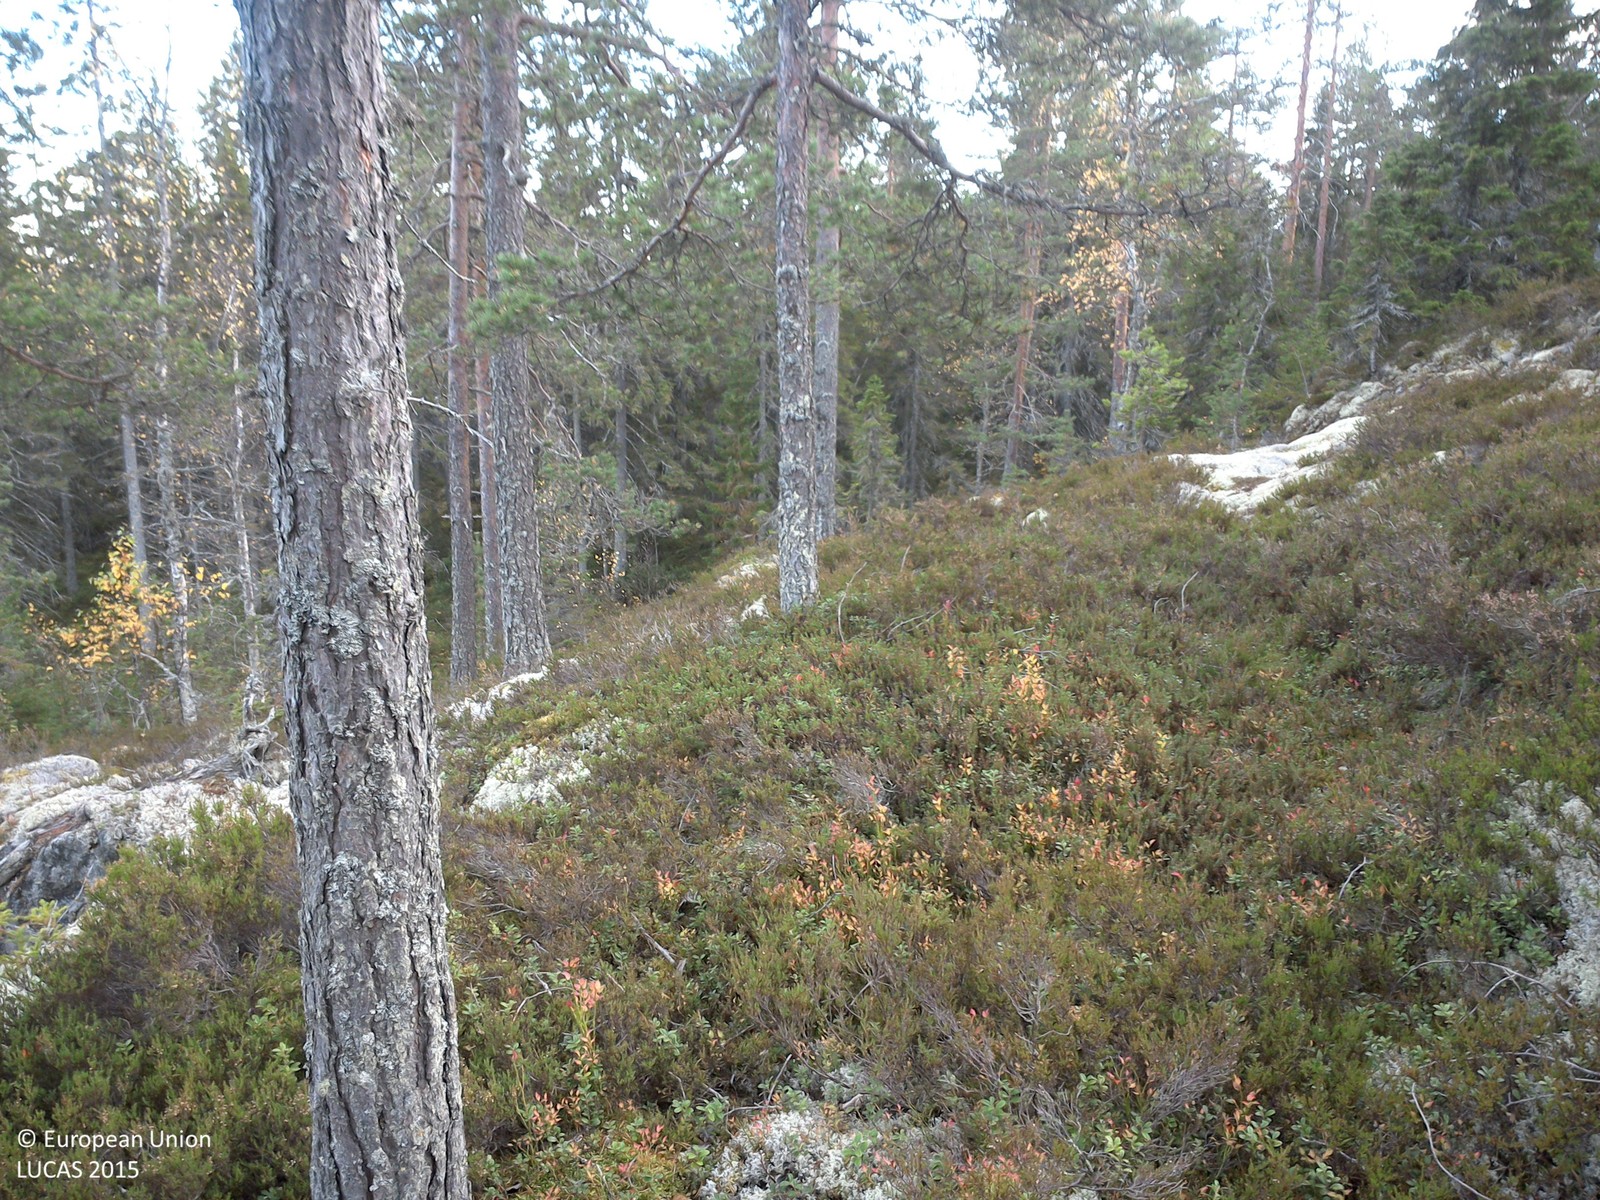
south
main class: Woodland
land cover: Pine dominated coniferous woodland
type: boreal forest
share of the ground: 25 - 50 %
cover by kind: coniferous forest trees 50 %, shrubs 20 %, lichens and mosses 20 %, consolidated bare surface 10 %
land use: Forestry
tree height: > 5 m
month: October
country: SE
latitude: 63.8524
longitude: 19.8841
